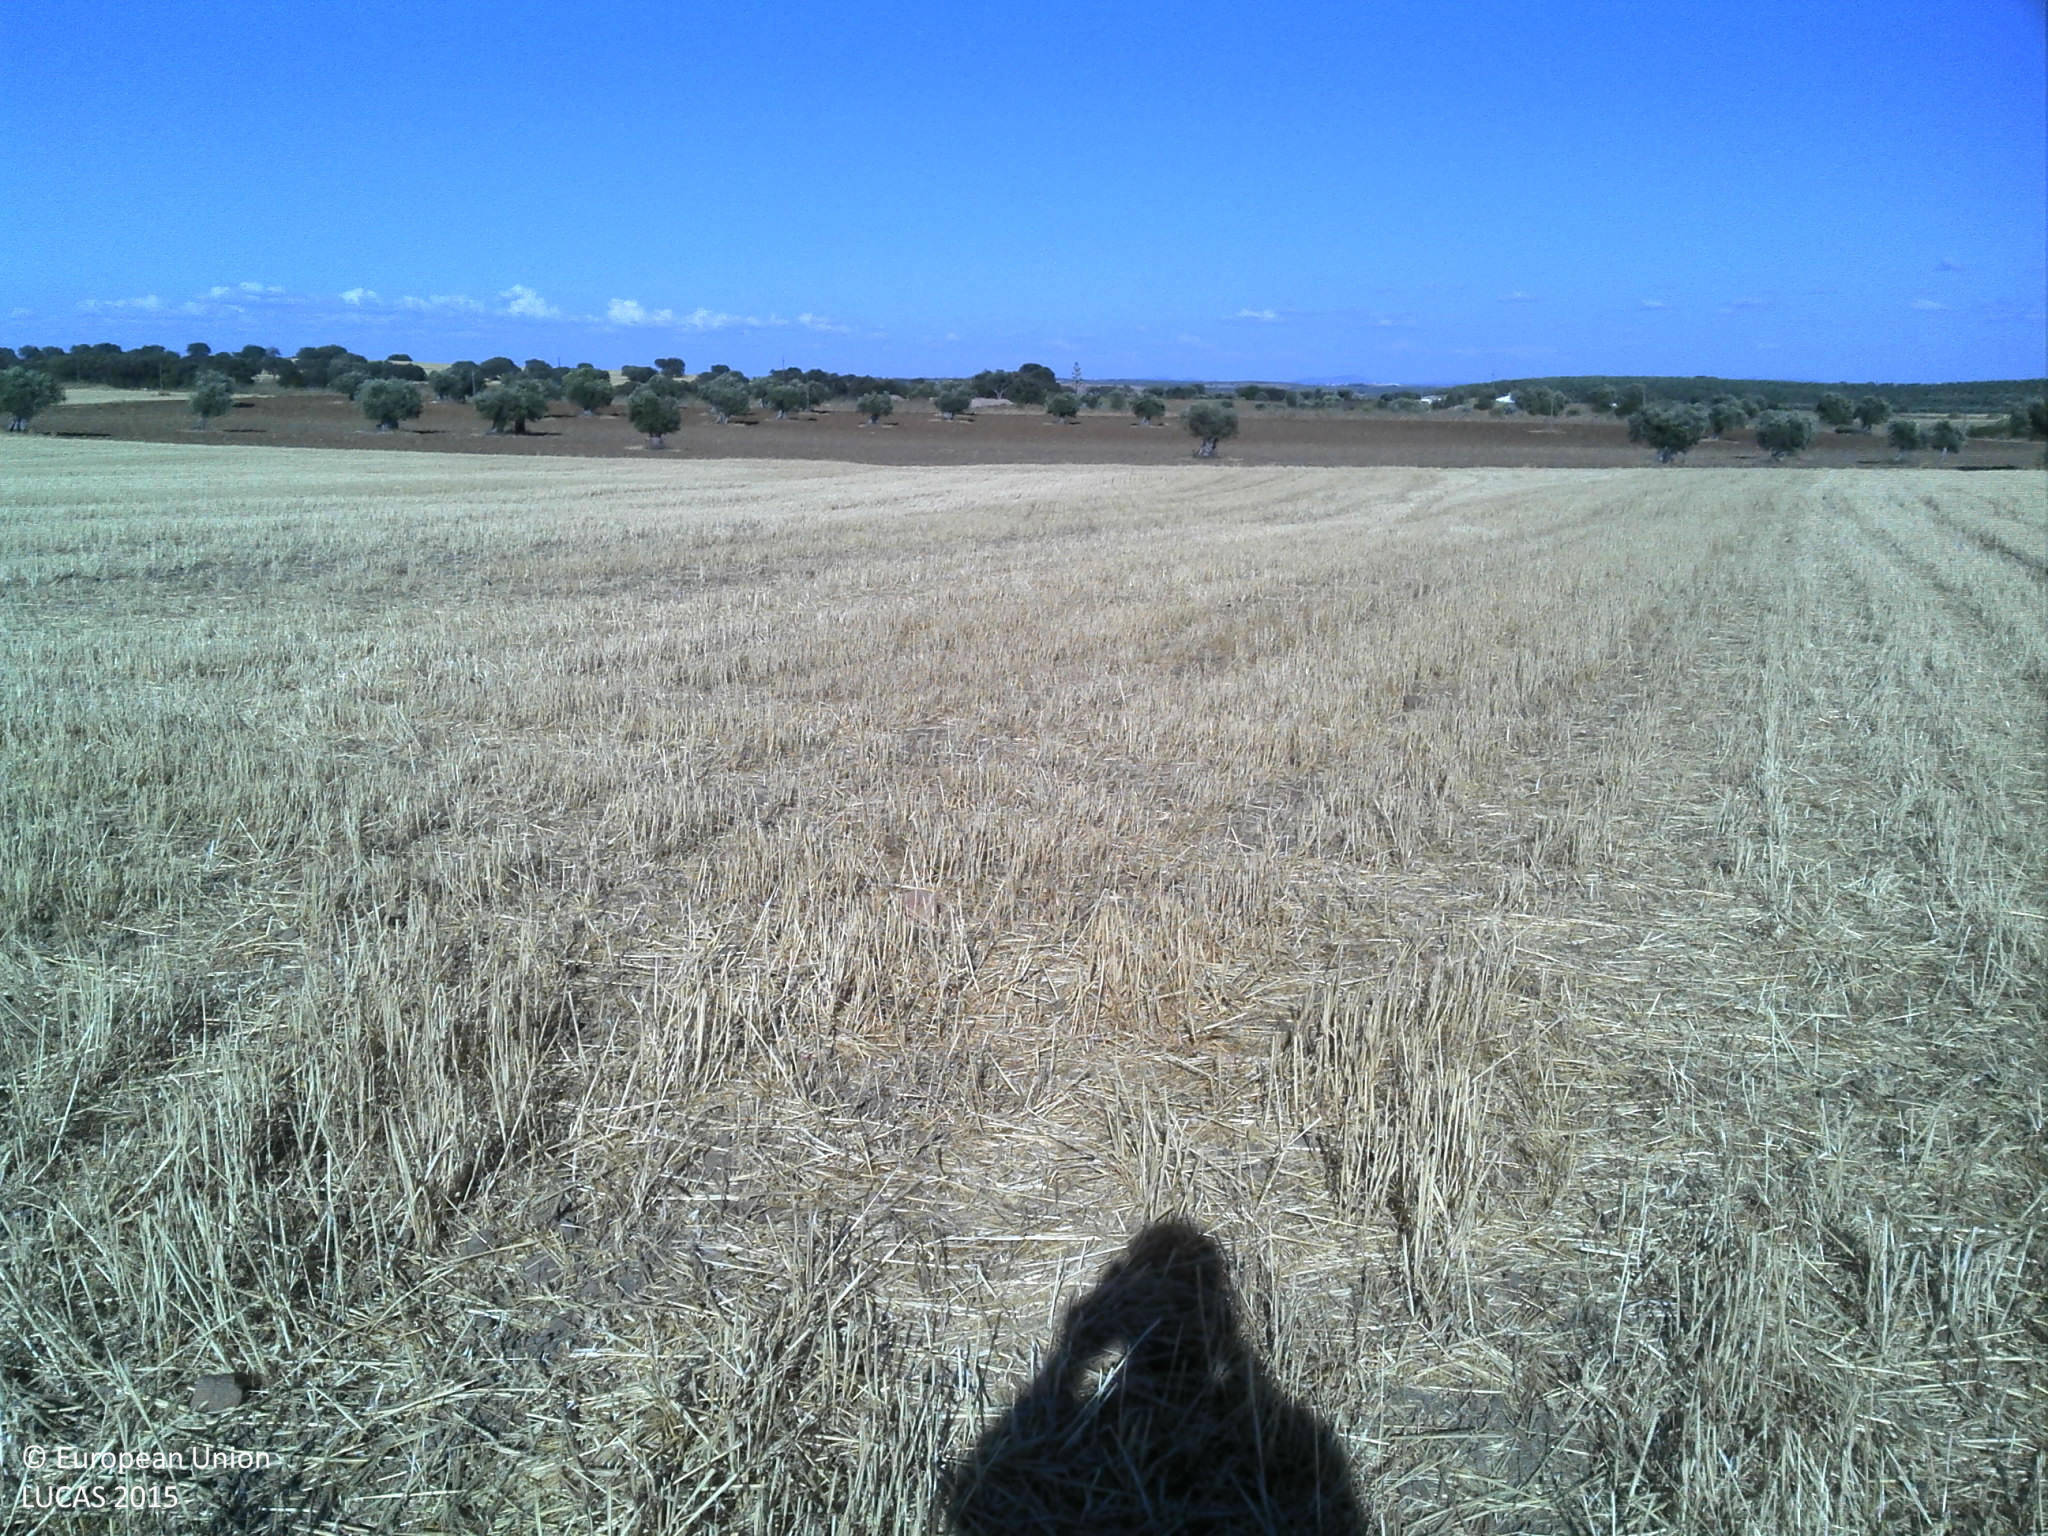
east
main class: Cropland
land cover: Barley
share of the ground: > 75 %
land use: Agriculture (excluding fallow land and kitchen gardens)
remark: Harvested field
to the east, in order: Barley; Other bare soil; Tracks; Other bare soil; Olive groves
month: July
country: PT
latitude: 38.0404
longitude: -7.8601
